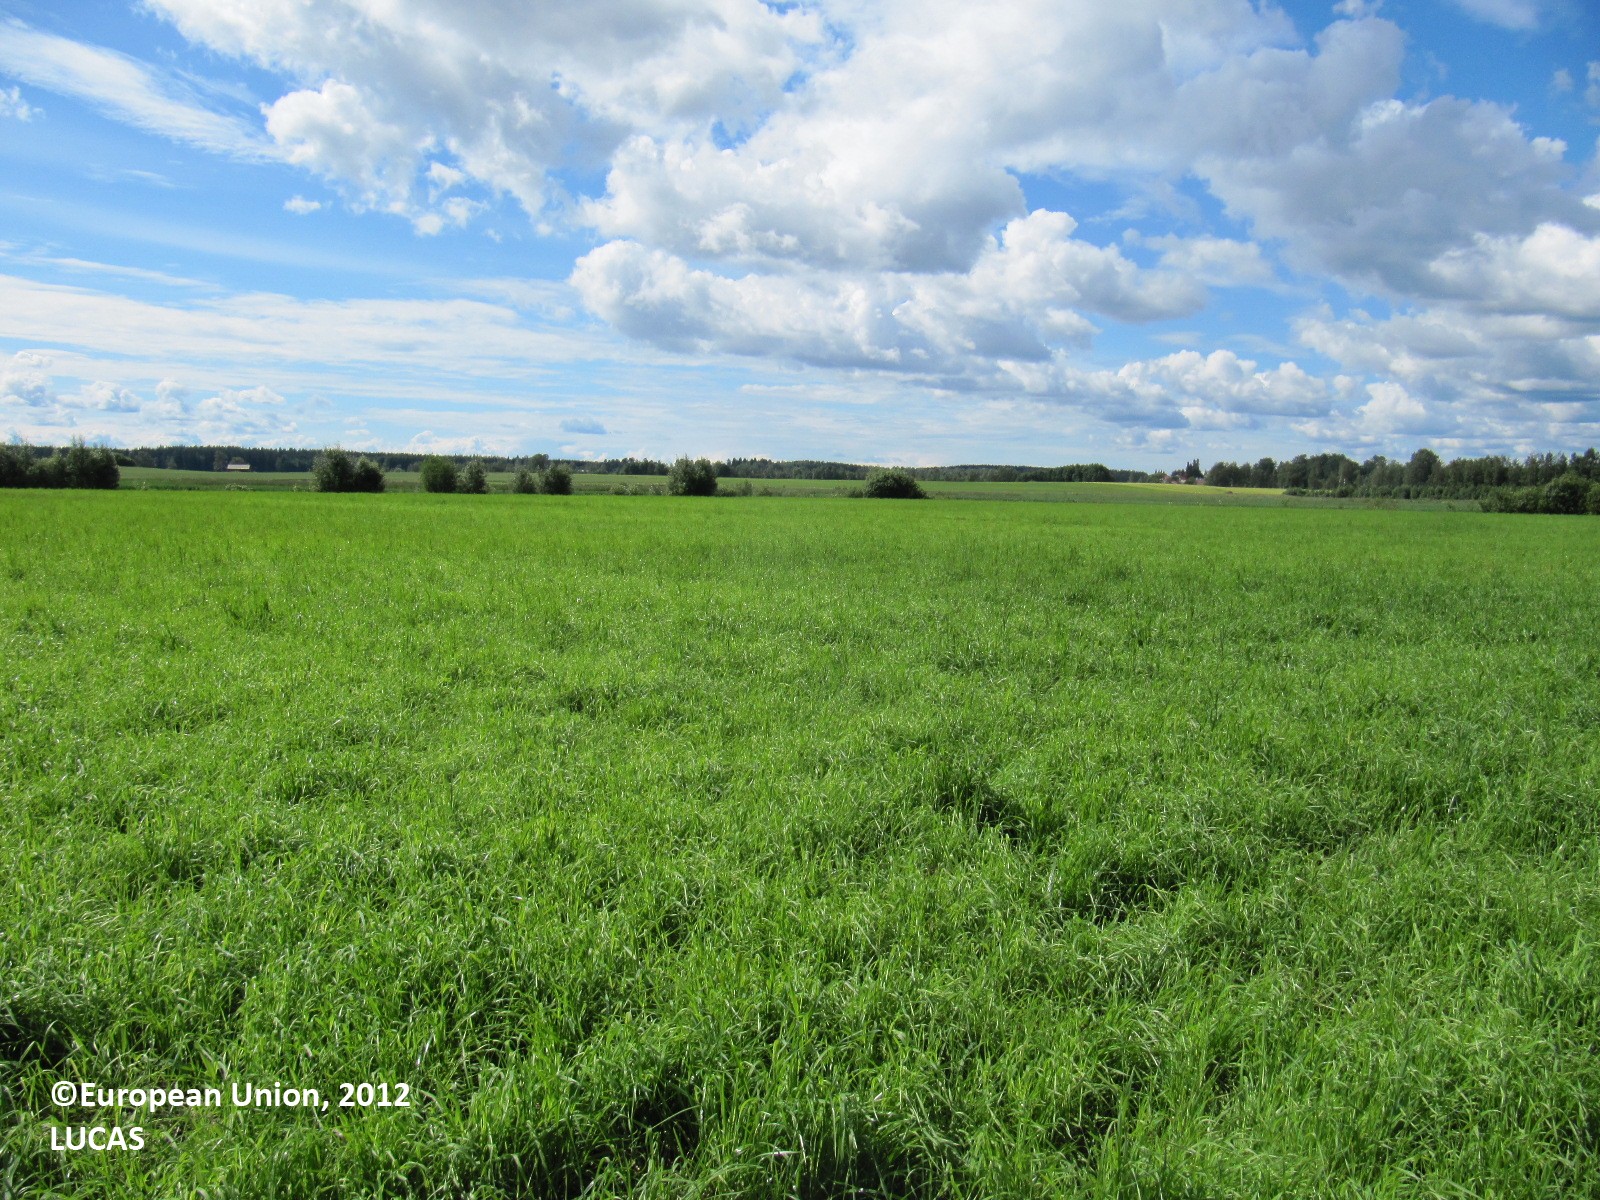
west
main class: Grassland
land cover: Spontaneously vegetated surfaces
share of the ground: > 75 %
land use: Agriculture (excluding fallow land and kitchen gardens)
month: July
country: FI
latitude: 61.1404
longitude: 24.6092
